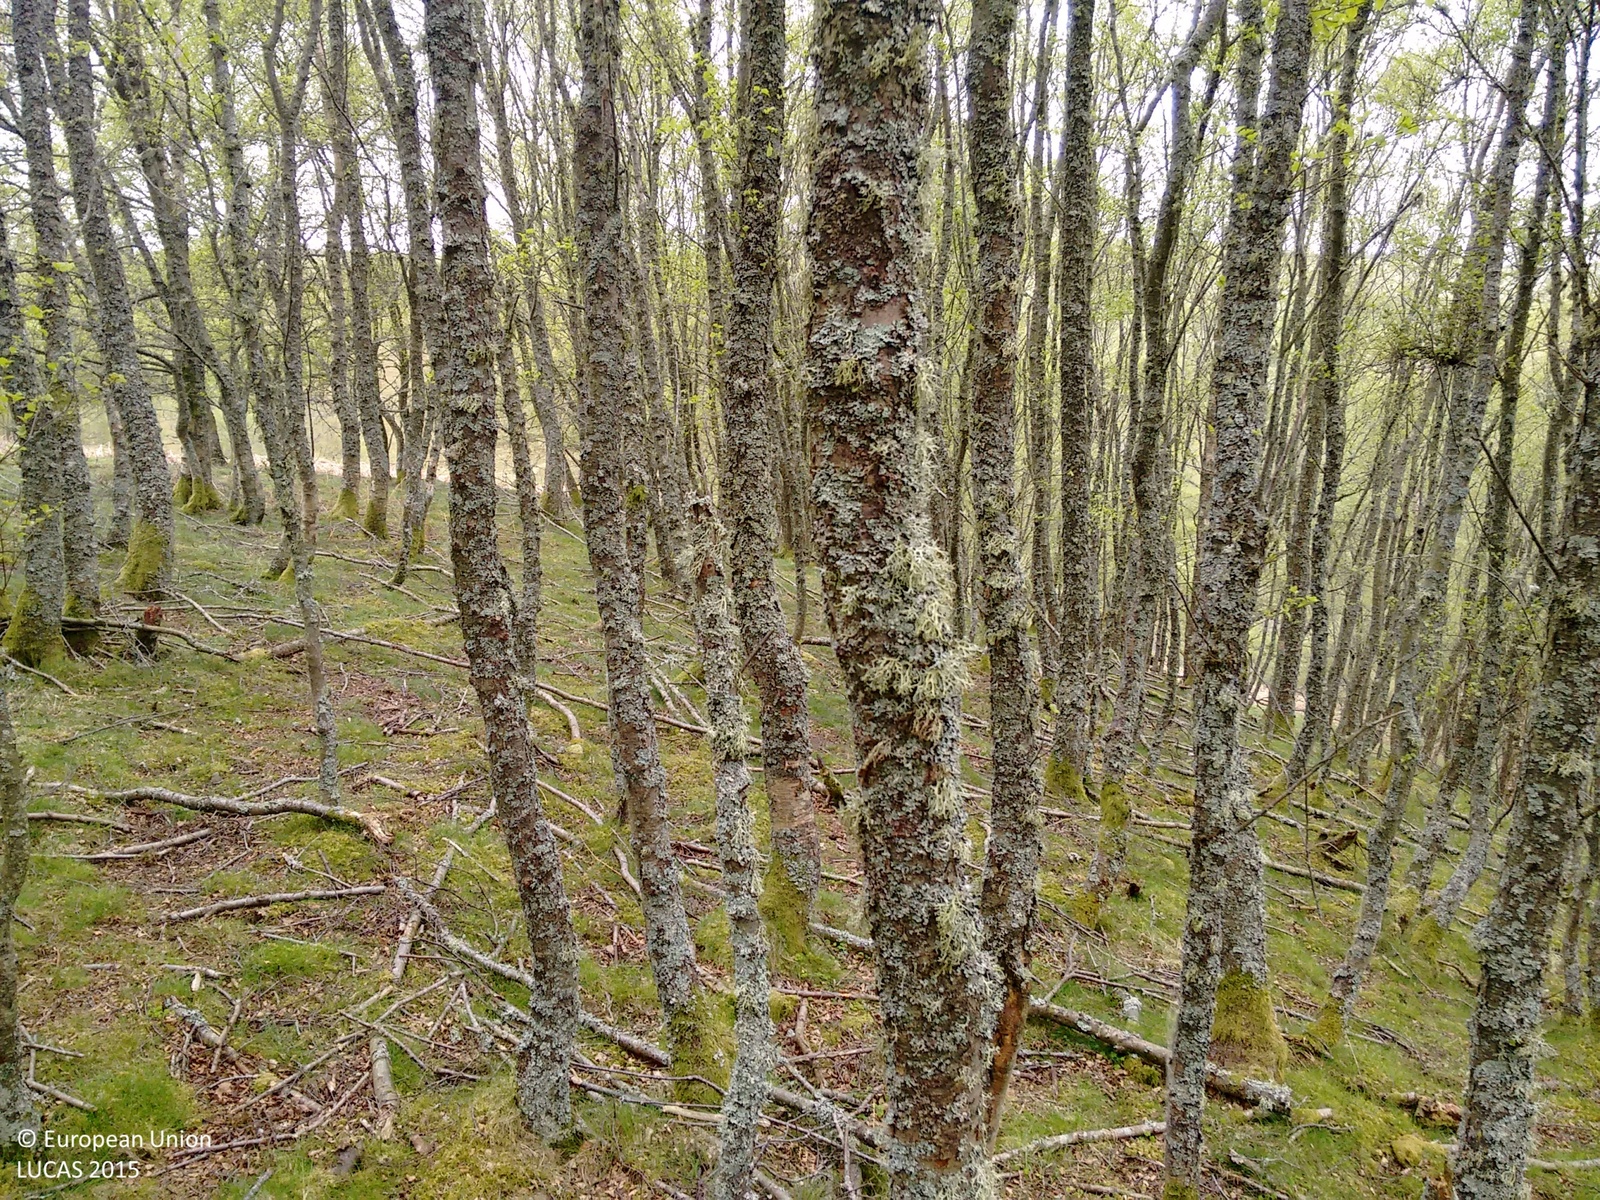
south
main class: Woodland
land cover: Broadleaved woodland
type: non-riverine alder, birch or aspen forest
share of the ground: > 75 %
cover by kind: broadleaved forest trees 85 %, herbaceous plants 10 %, lichens and mosses 5 %
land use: Semi-natural and natural areas not in use
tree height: > 5 m
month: May
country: GB
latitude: 56.7145
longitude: -3.1209
